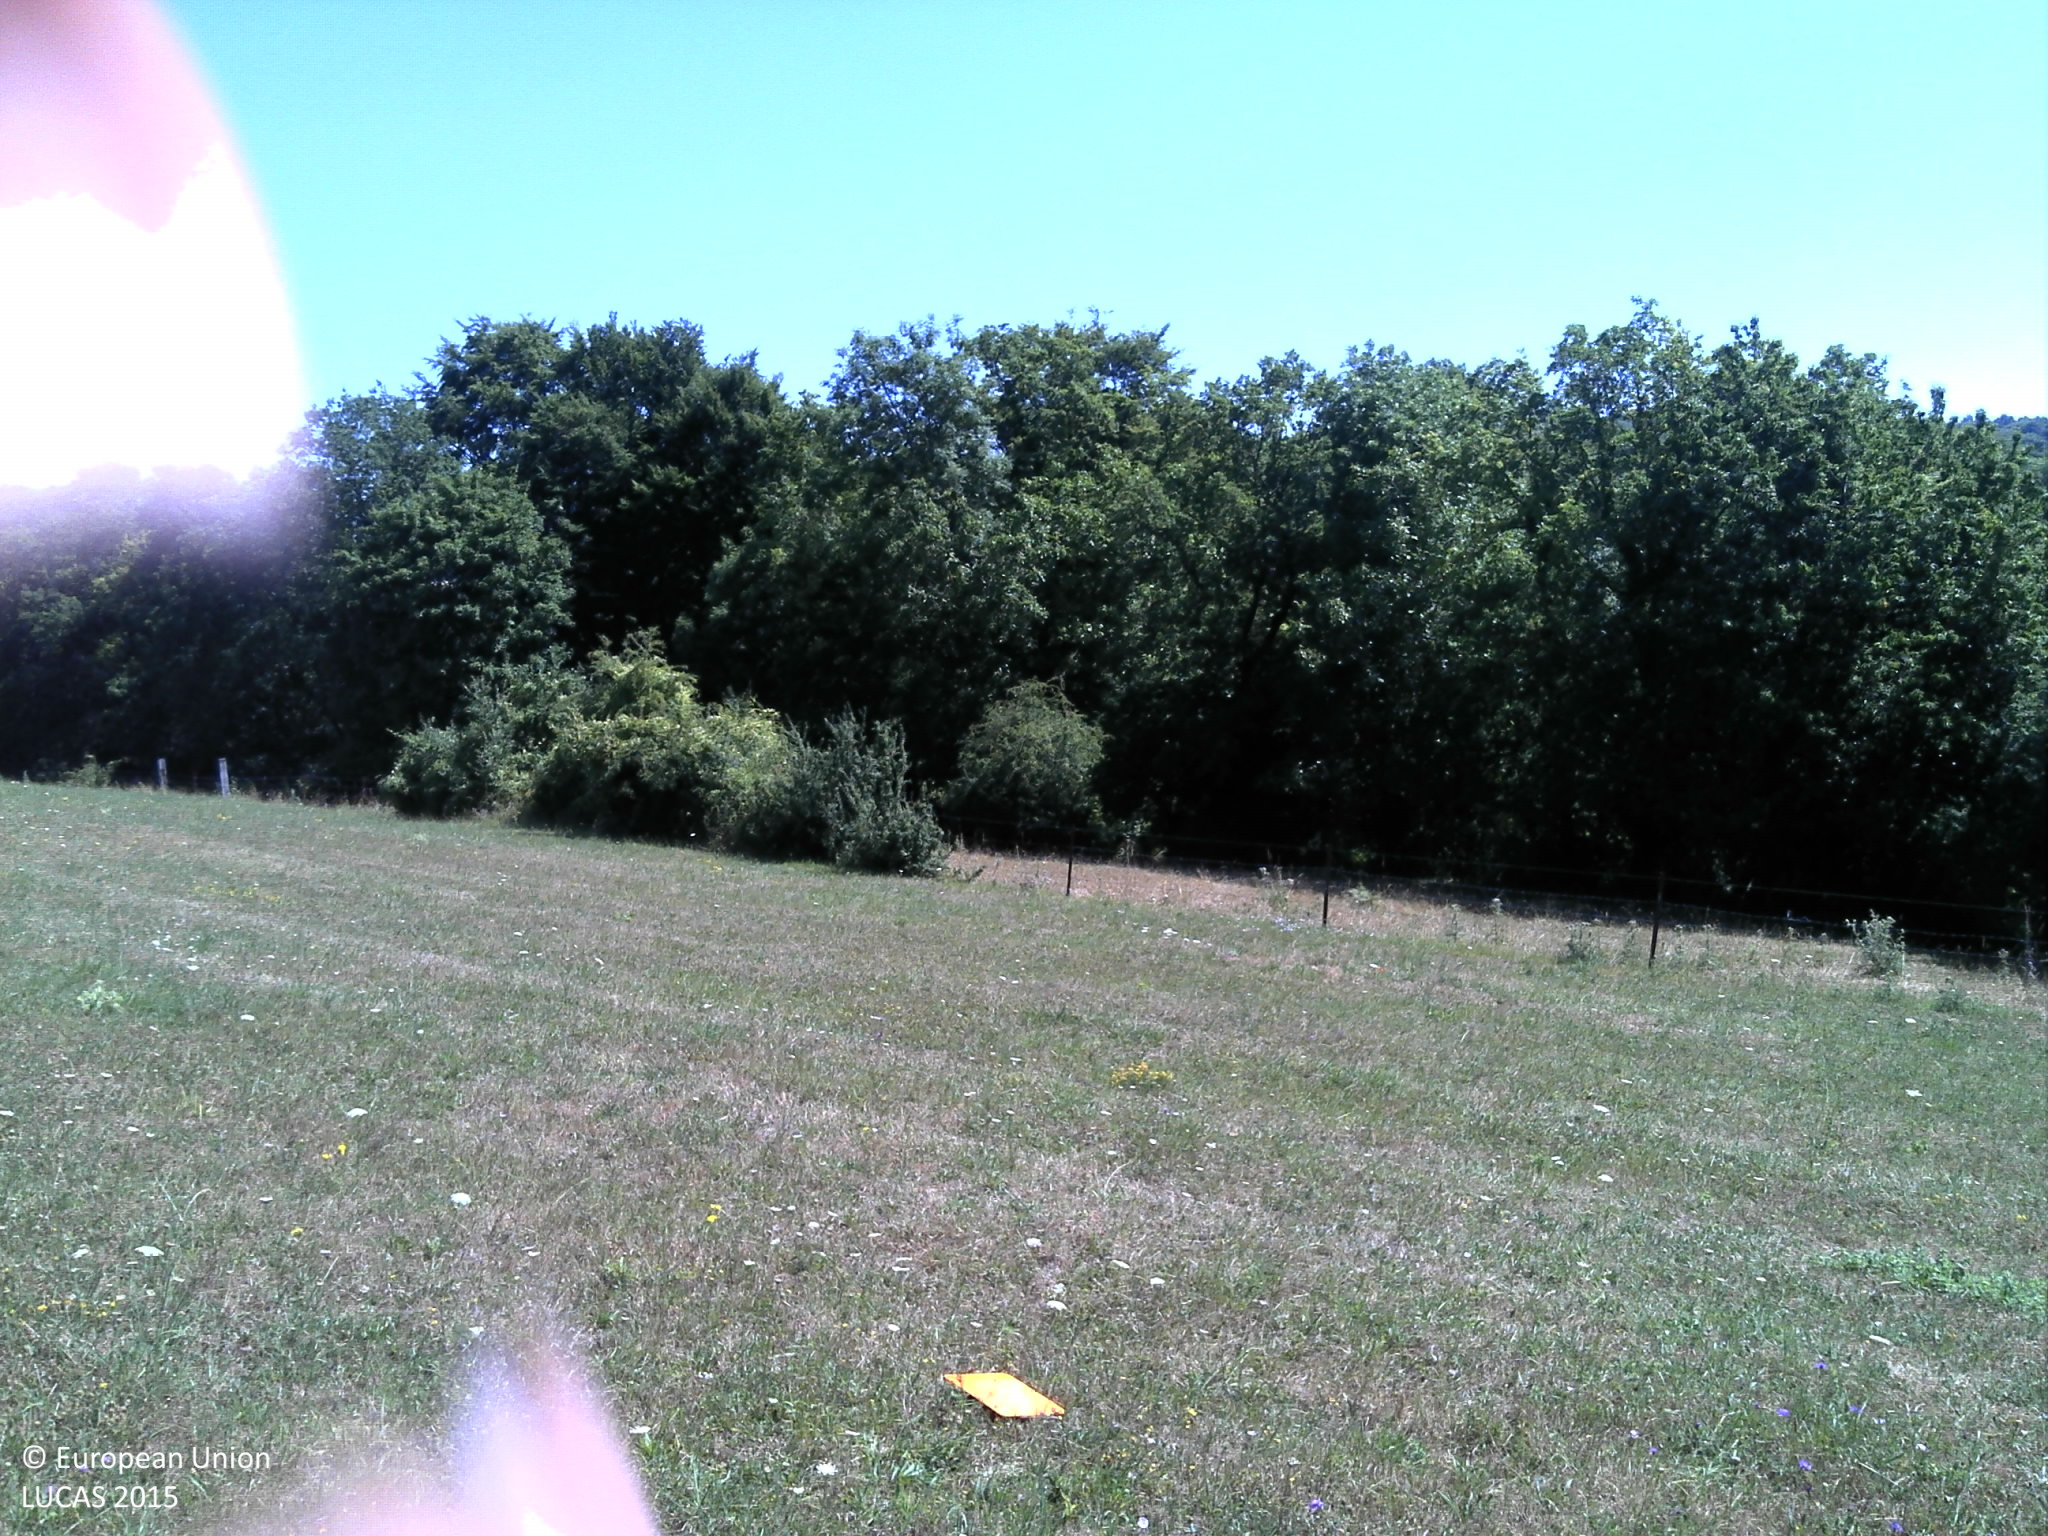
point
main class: Grassland
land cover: Grassland without tree/shrub cover
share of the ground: > 75 %
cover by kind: herbaceous plants 100 %
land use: Agriculture (excluding fallow land and kitchen gardens)
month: July
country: FR
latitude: 49.5884
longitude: 4.6155
